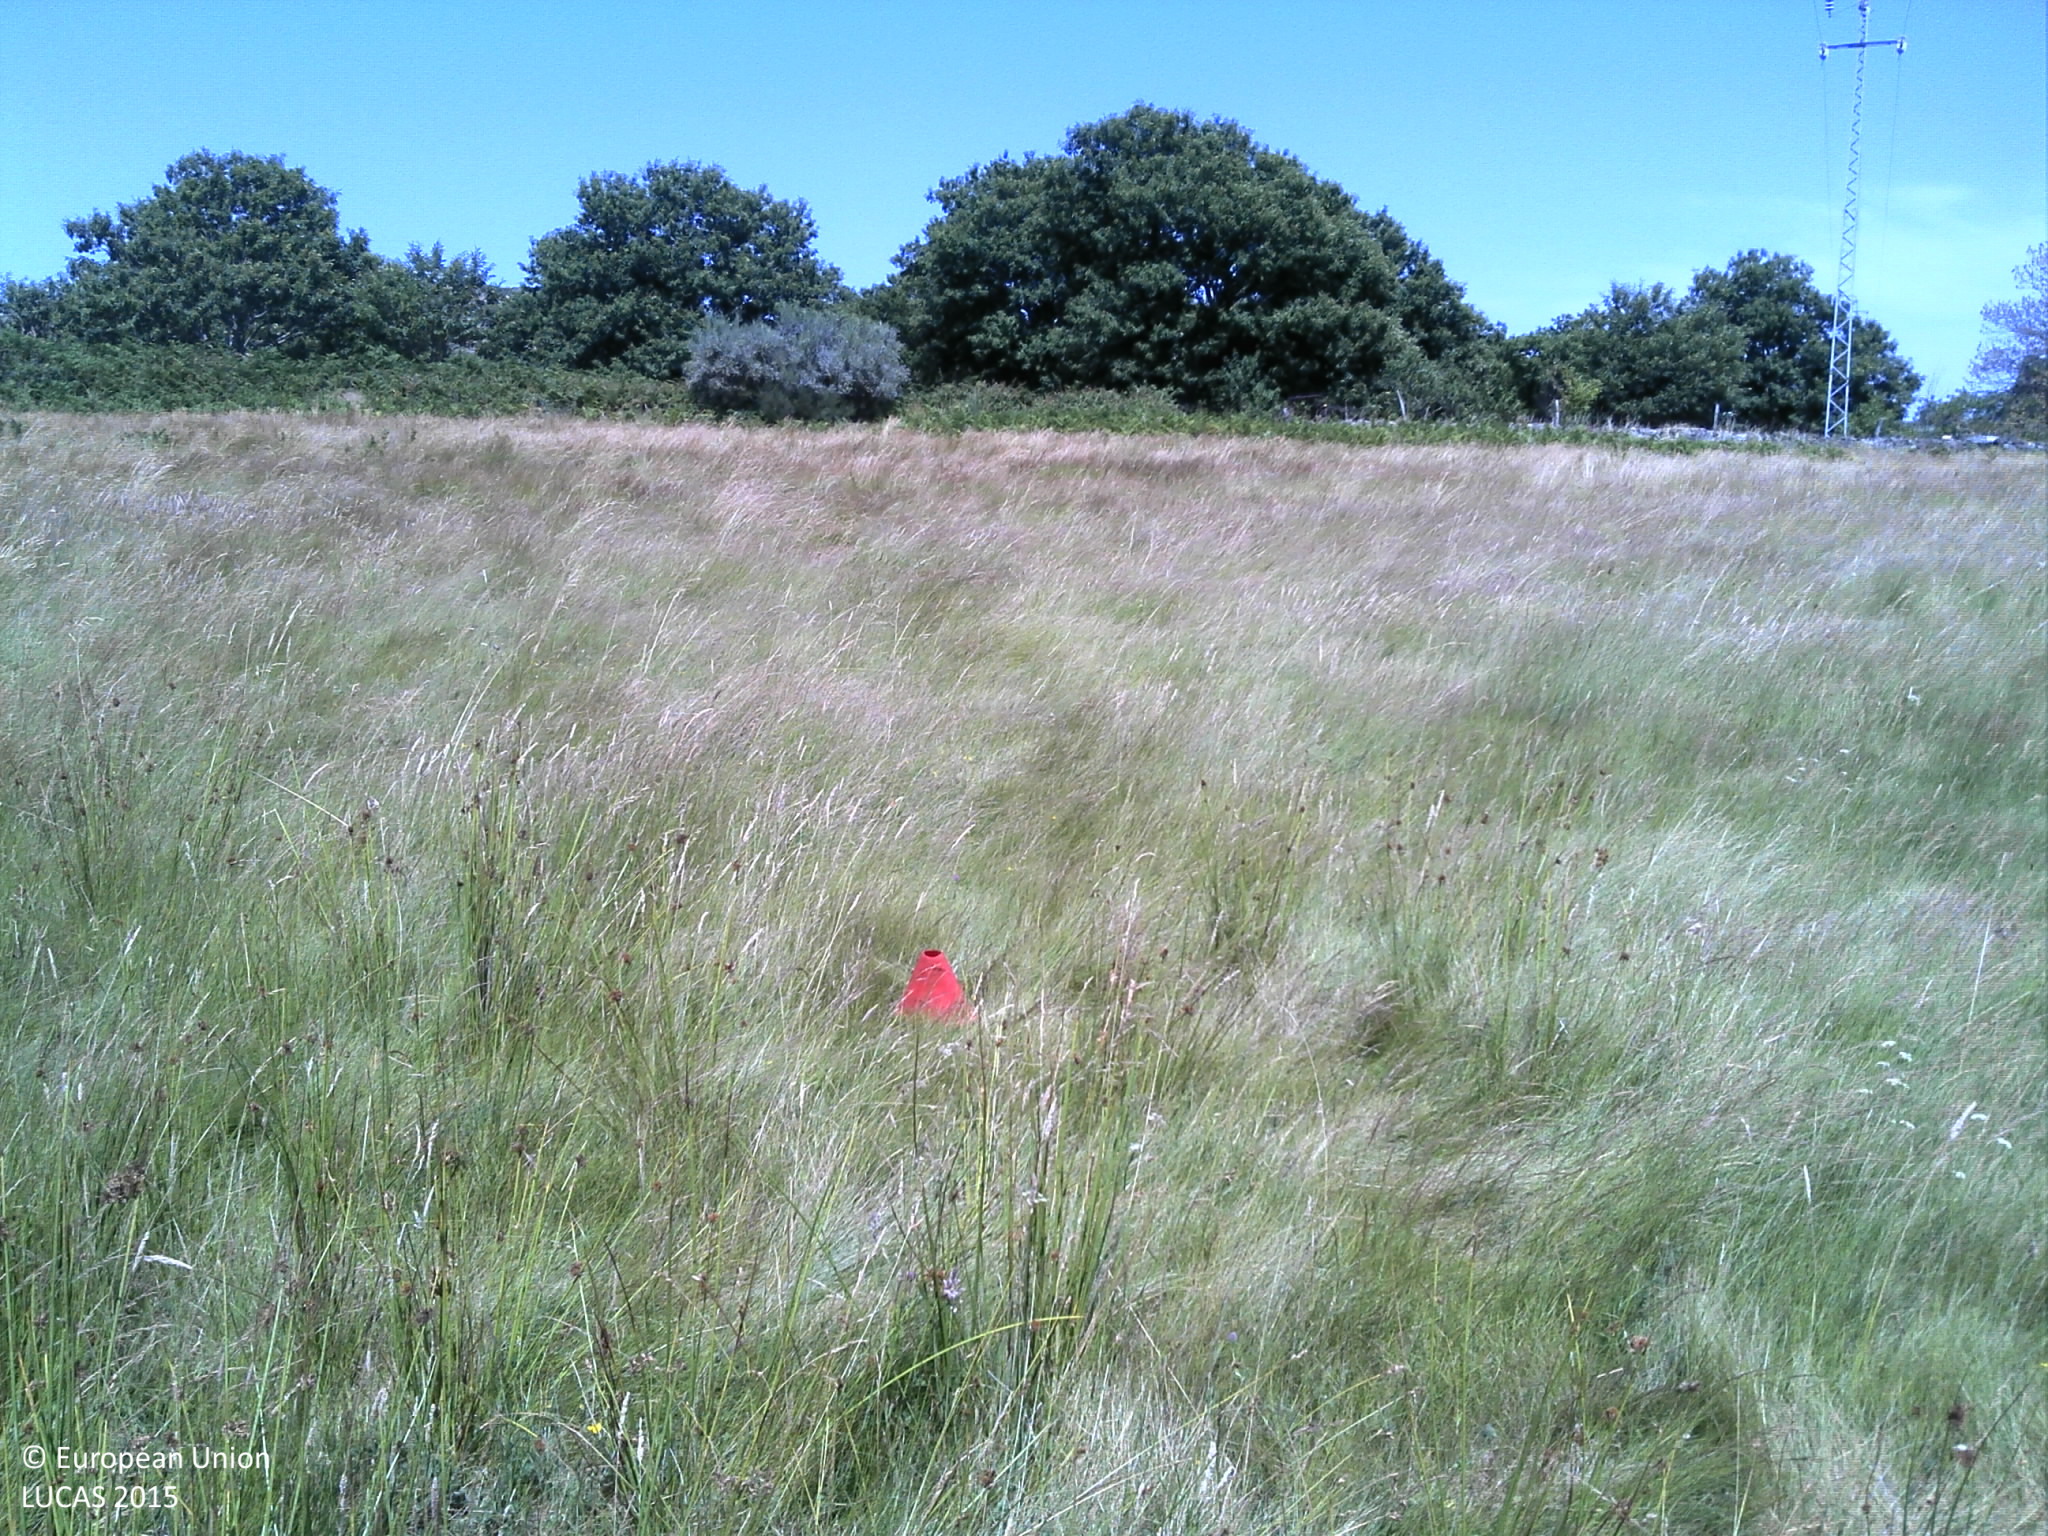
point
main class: Grassland
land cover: Grassland without tree/shrub cover
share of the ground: > 75 %
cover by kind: herbaceous plants 90 %, unconsolidated bare surface 10 %
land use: Agriculture (excluding fallow land and kitchen gardens)
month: July
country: PT
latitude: 41.0334
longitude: -7.4488
